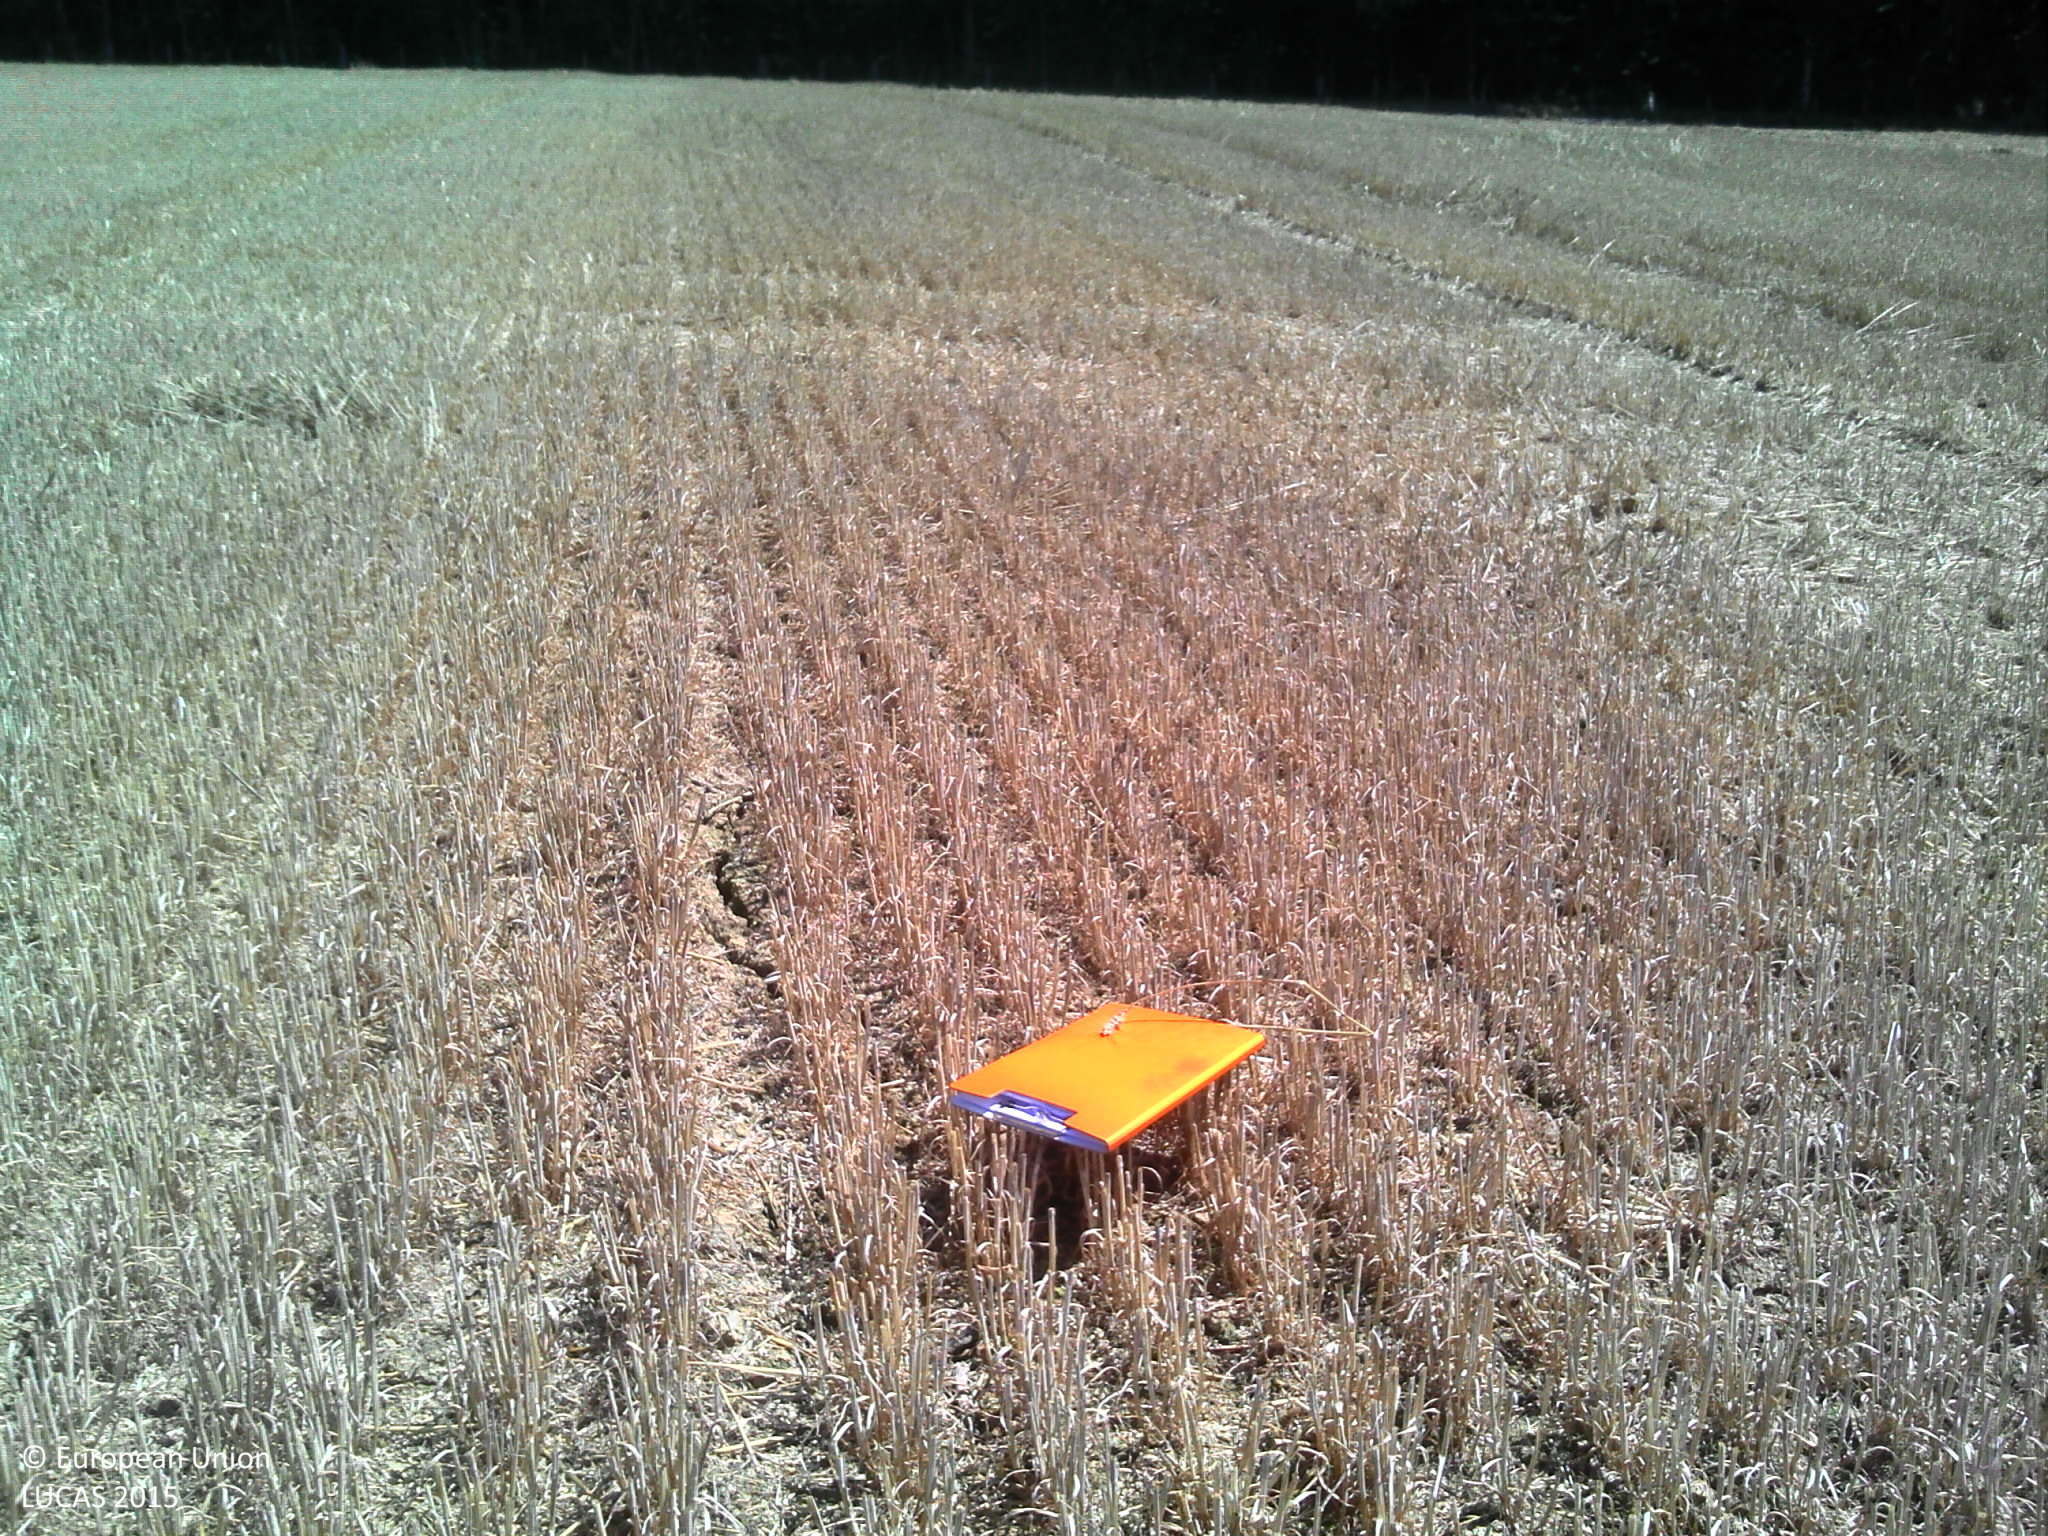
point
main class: Cropland
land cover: Common wheat
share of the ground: 10 - 25 %
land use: Agriculture (excluding fallow land and kitchen gardens)
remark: Harvested field
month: August
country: FR
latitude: 47.6709
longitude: 6.1788
